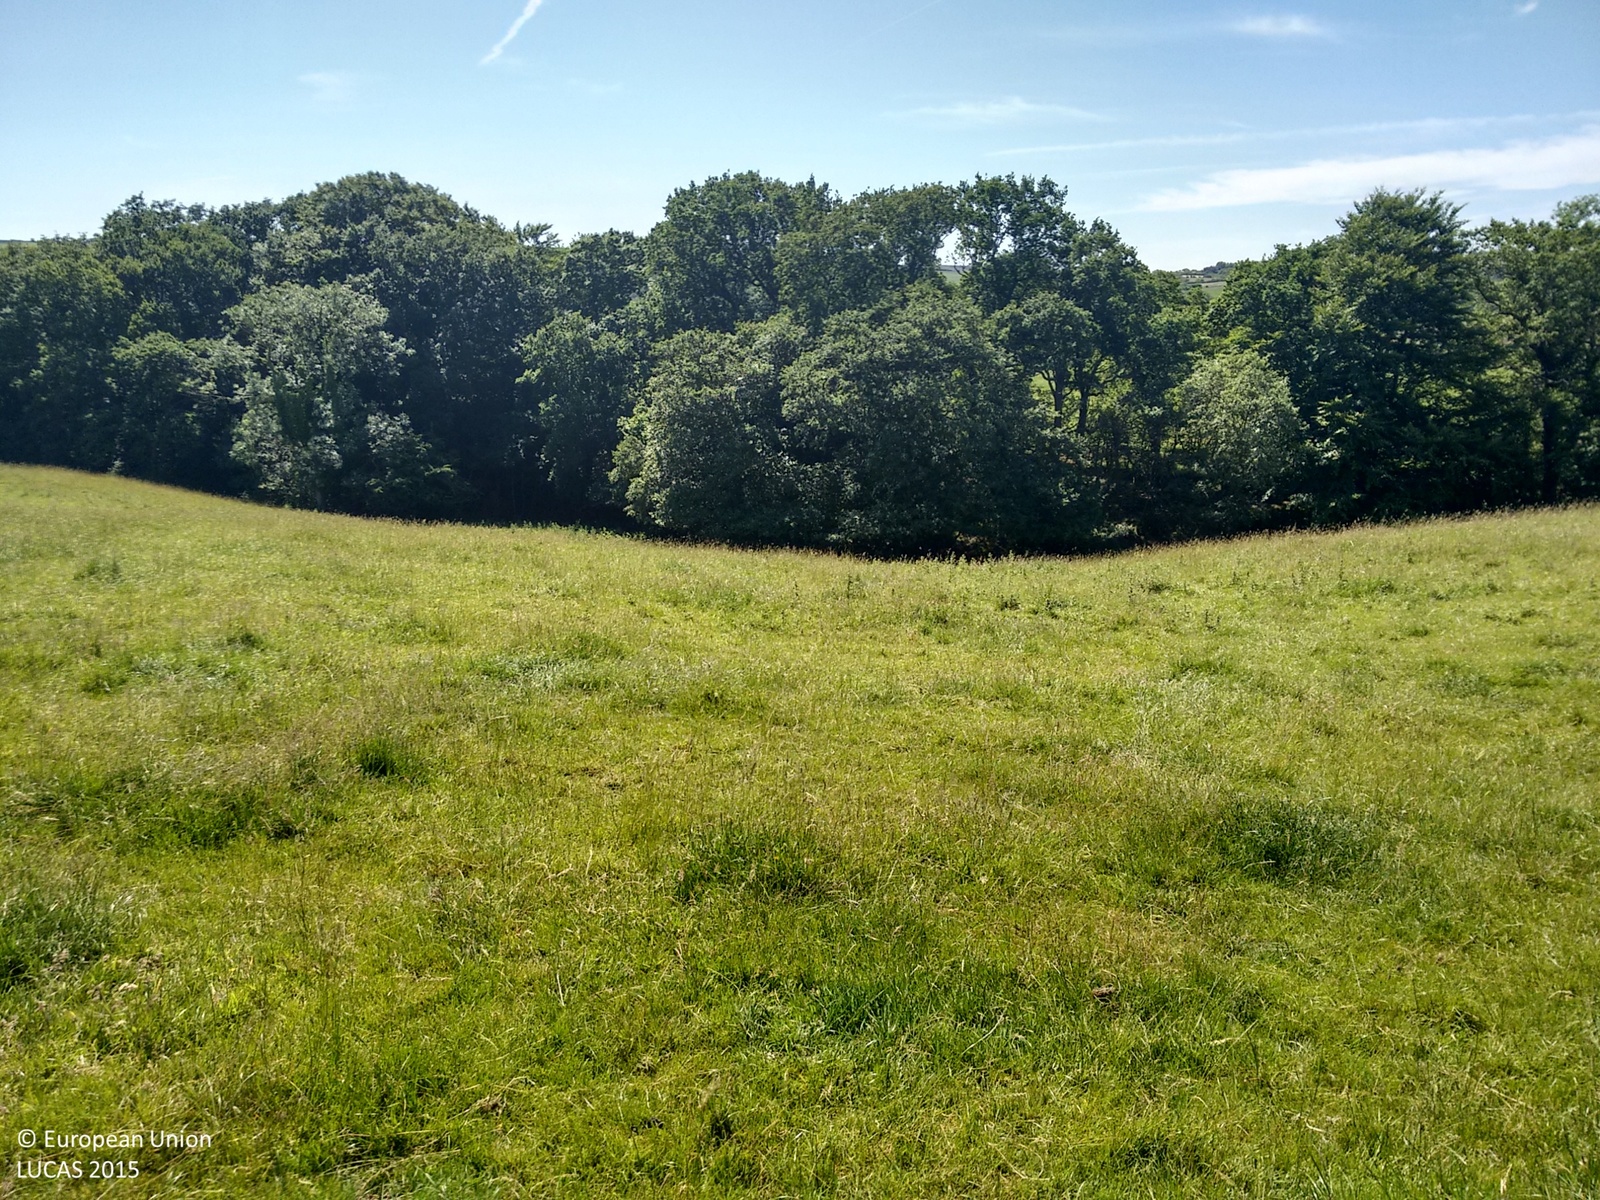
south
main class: Grassland
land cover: Grassland without tree/shrub cover
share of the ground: > 75 %
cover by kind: herbaceous plants 100 %
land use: Agriculture (excluding fallow land and kitchen gardens)
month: July
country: GB
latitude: 54.4082
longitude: -0.5594
